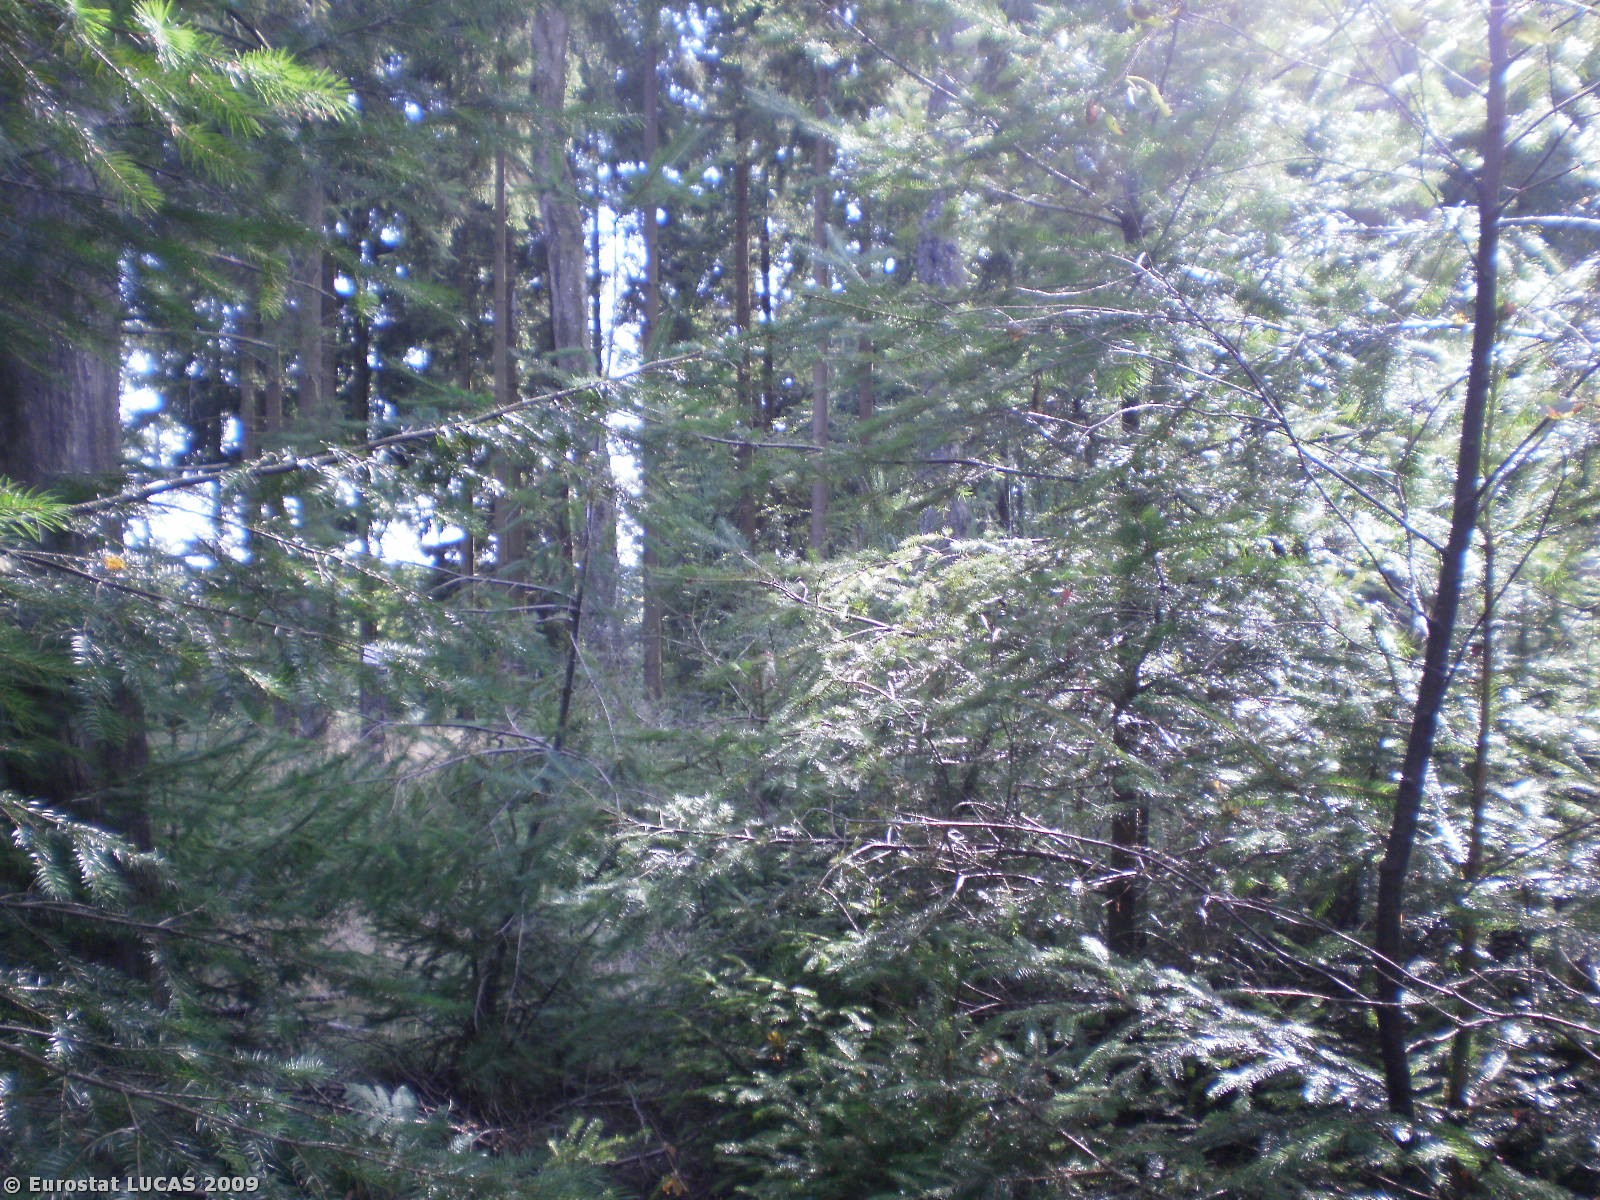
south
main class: Woodland
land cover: Mixed woodland
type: beech forest
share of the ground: > 75 %
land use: Forestry
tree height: > 5 m
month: September
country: BE
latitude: 50.3026
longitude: 6.2508
